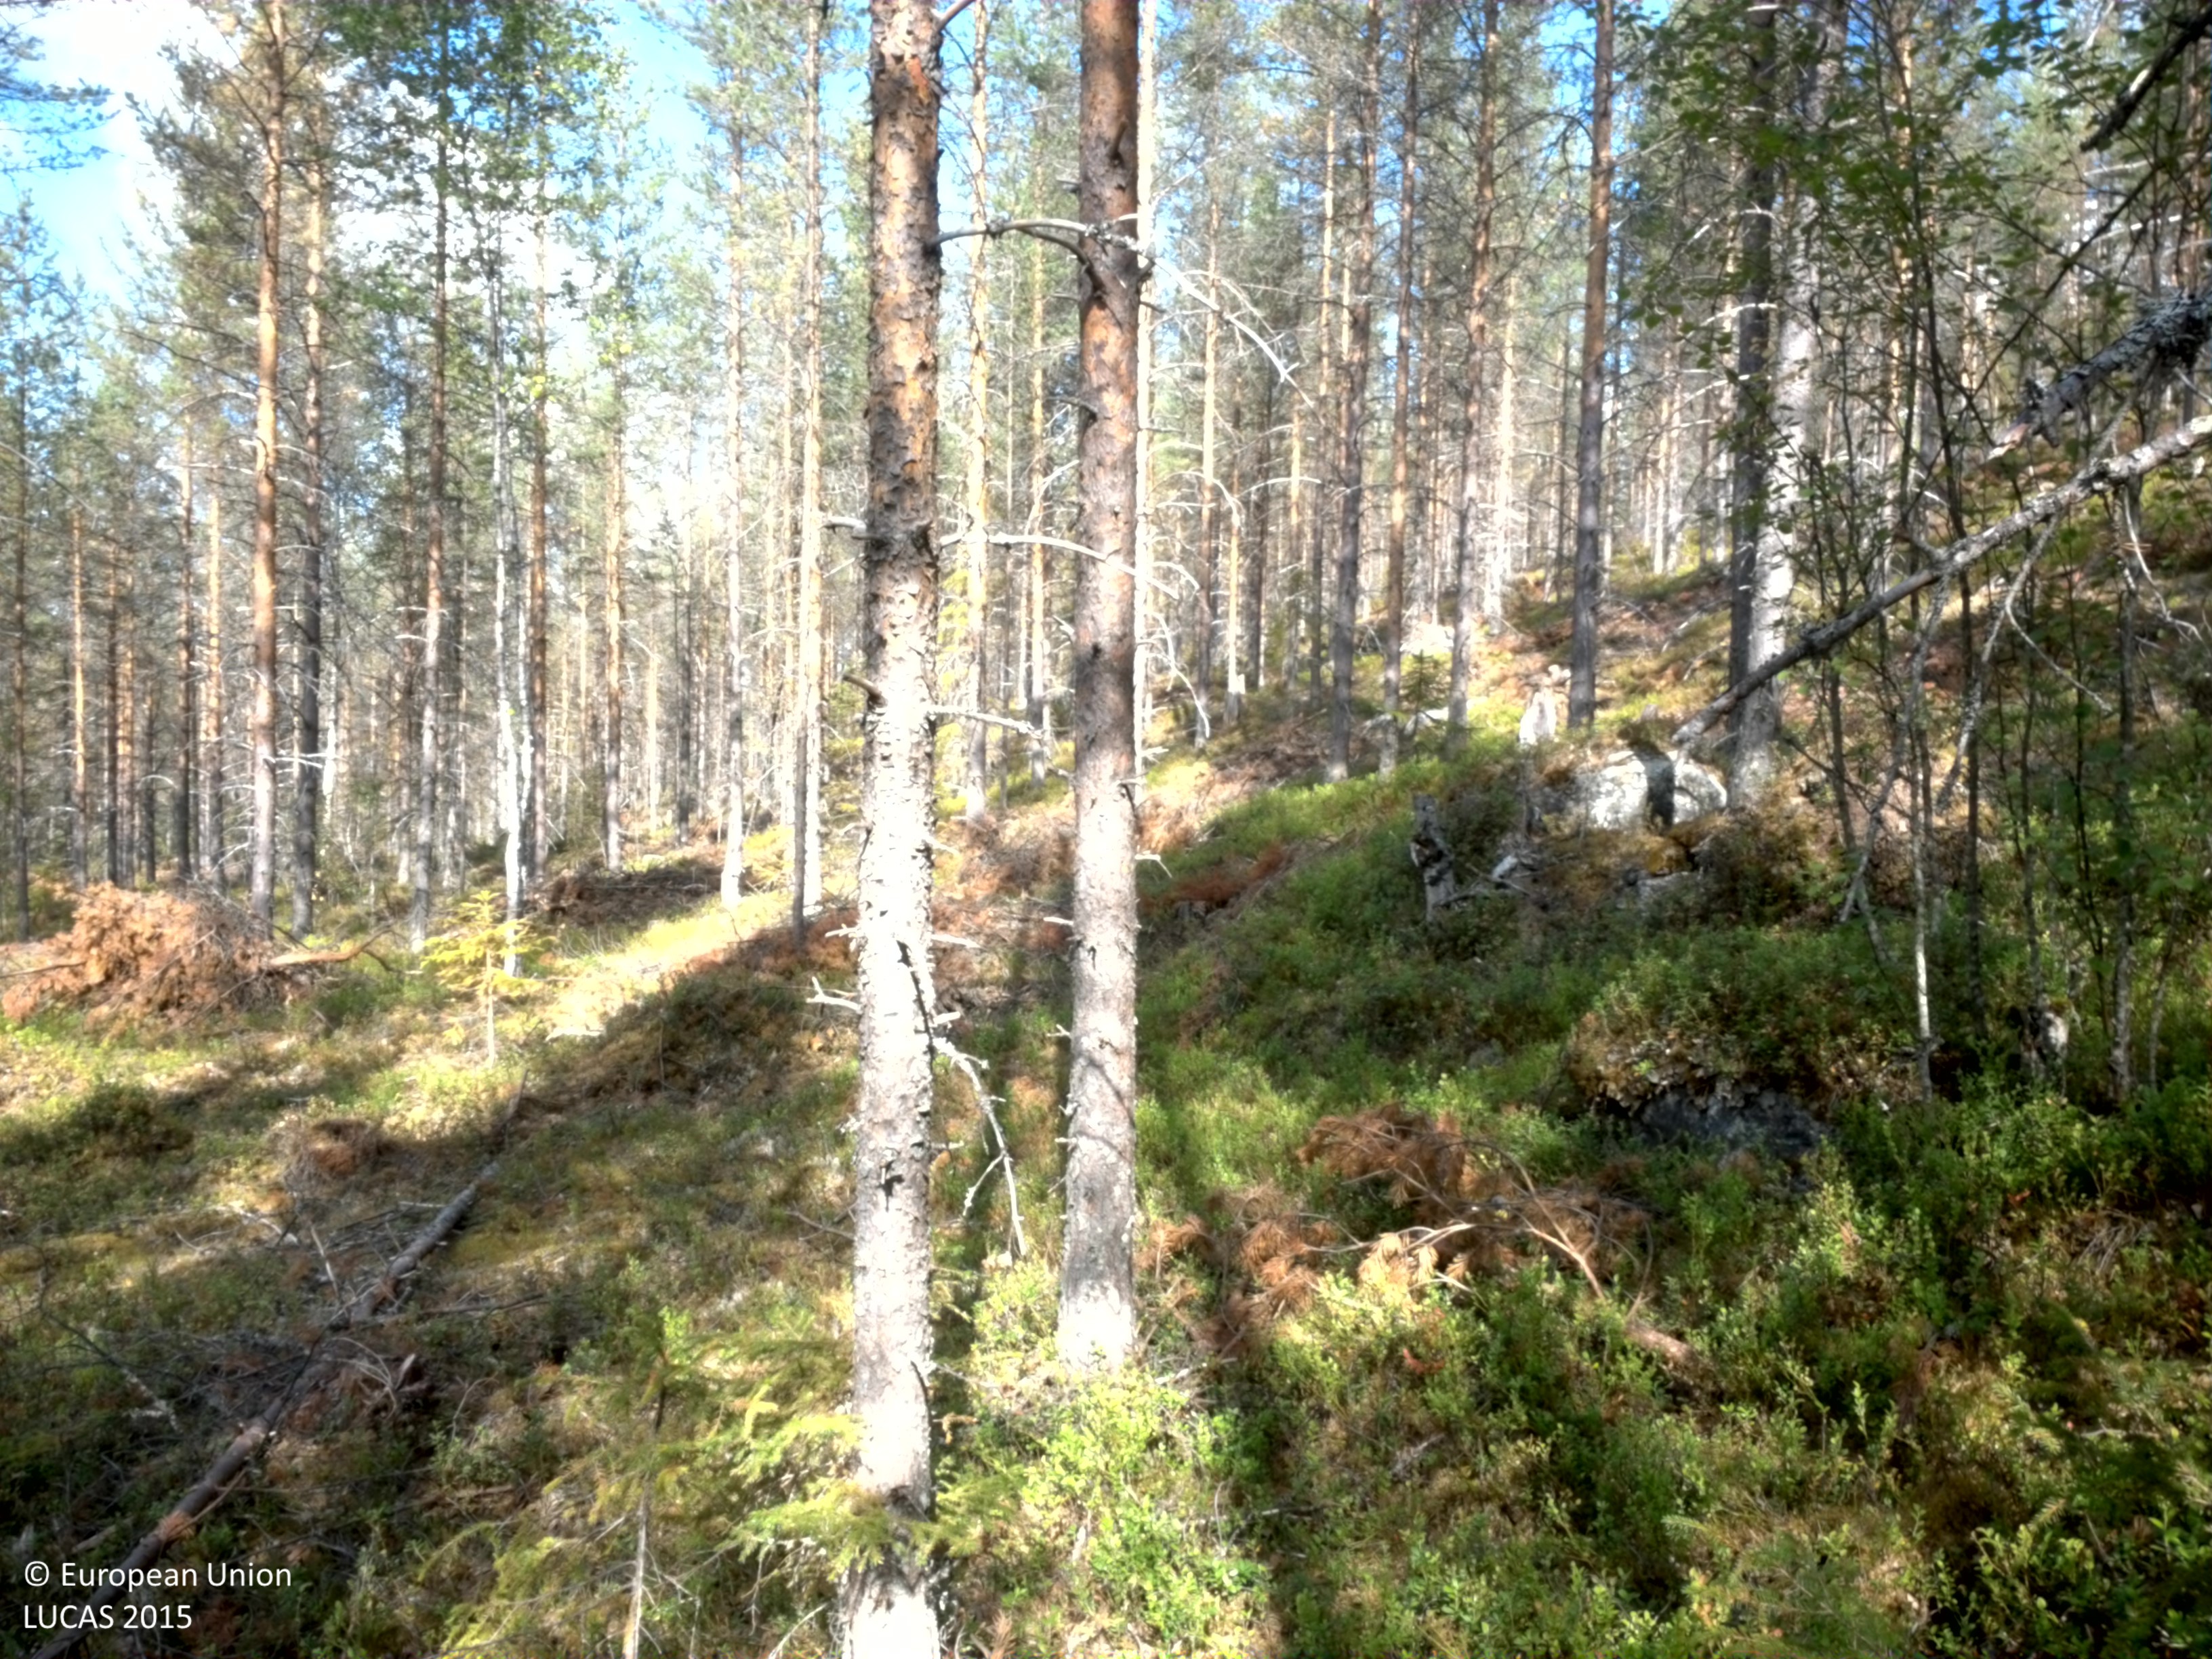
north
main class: Woodland
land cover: Pine dominated coniferous woodland
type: boreal forest
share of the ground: 50 - 75 %
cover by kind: coniferous forest trees 55 %, shrubs 40 %, lichens and mosses 5 %
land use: Forestry
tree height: > 5 m
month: August
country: SE
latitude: 64.5964
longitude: 19.0152
